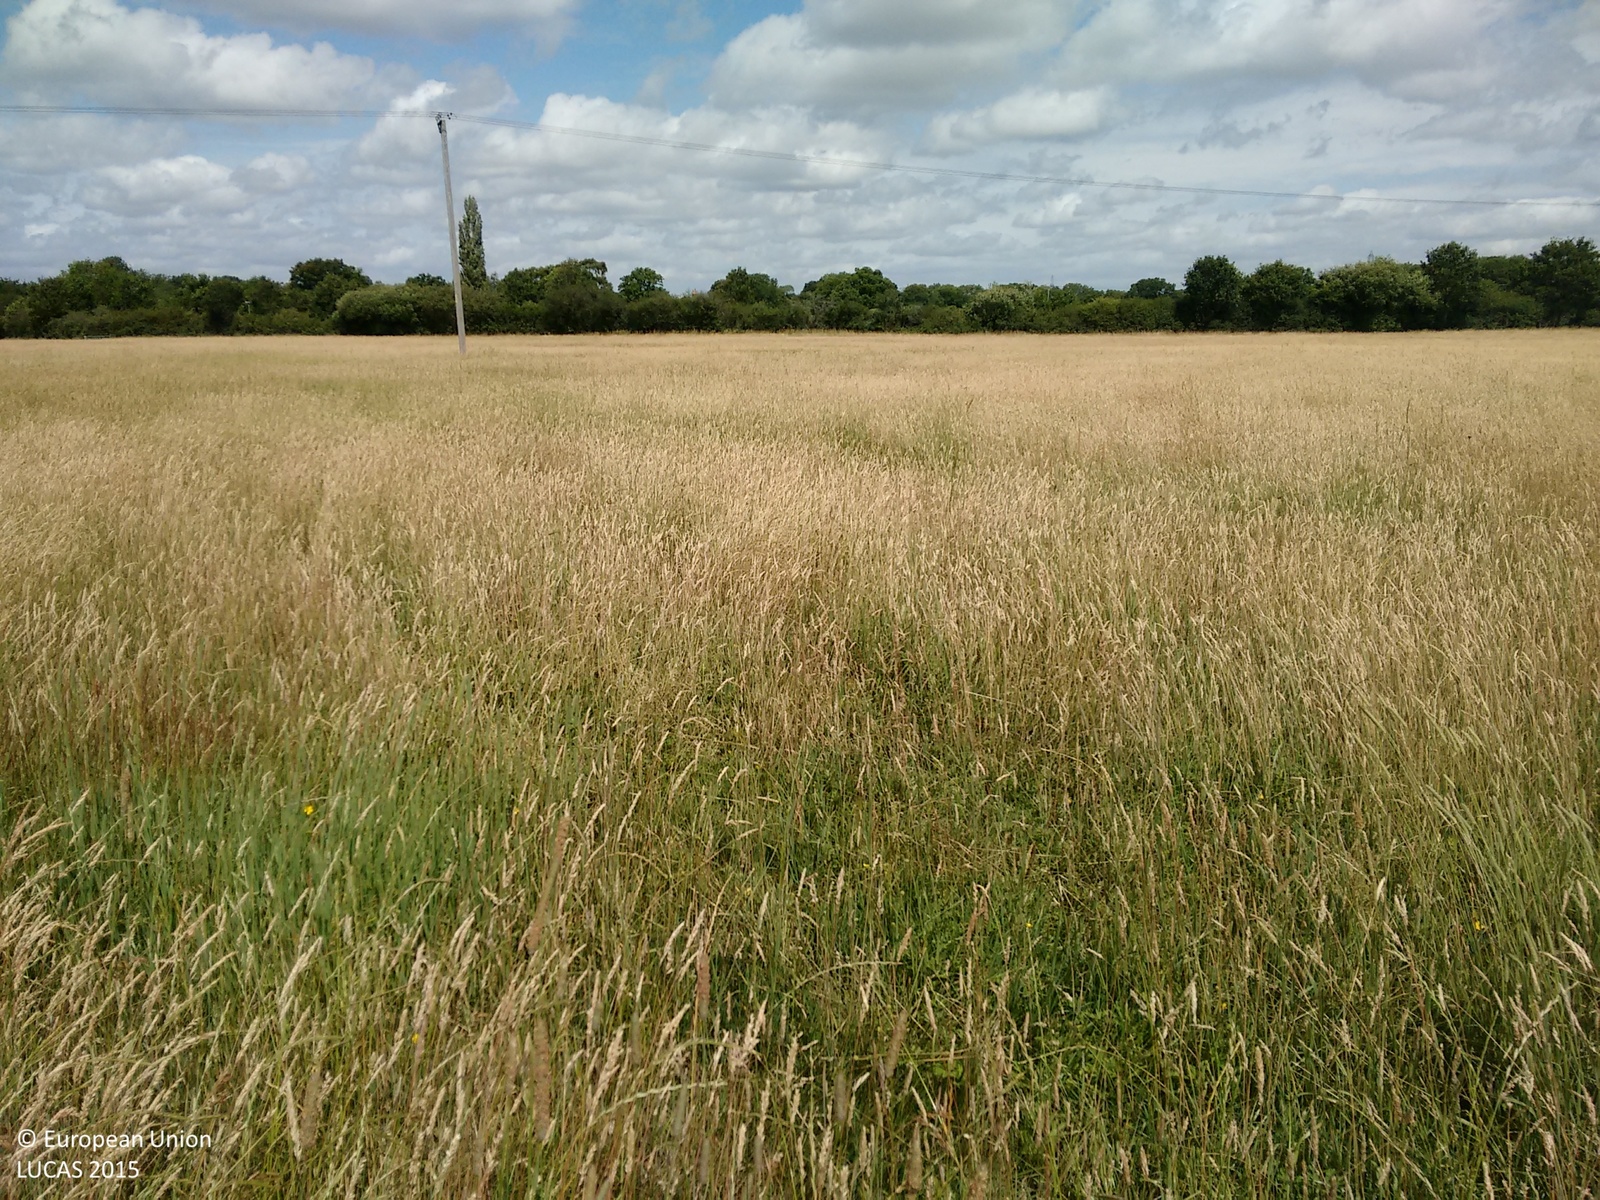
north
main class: Grassland
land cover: Grassland without tree/shrub cover
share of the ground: > 75 %
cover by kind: herbaceous plants 100 %
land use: Agriculture (excluding fallow land and kitchen gardens)
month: July
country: GB
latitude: 51.0103
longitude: -0.4278
